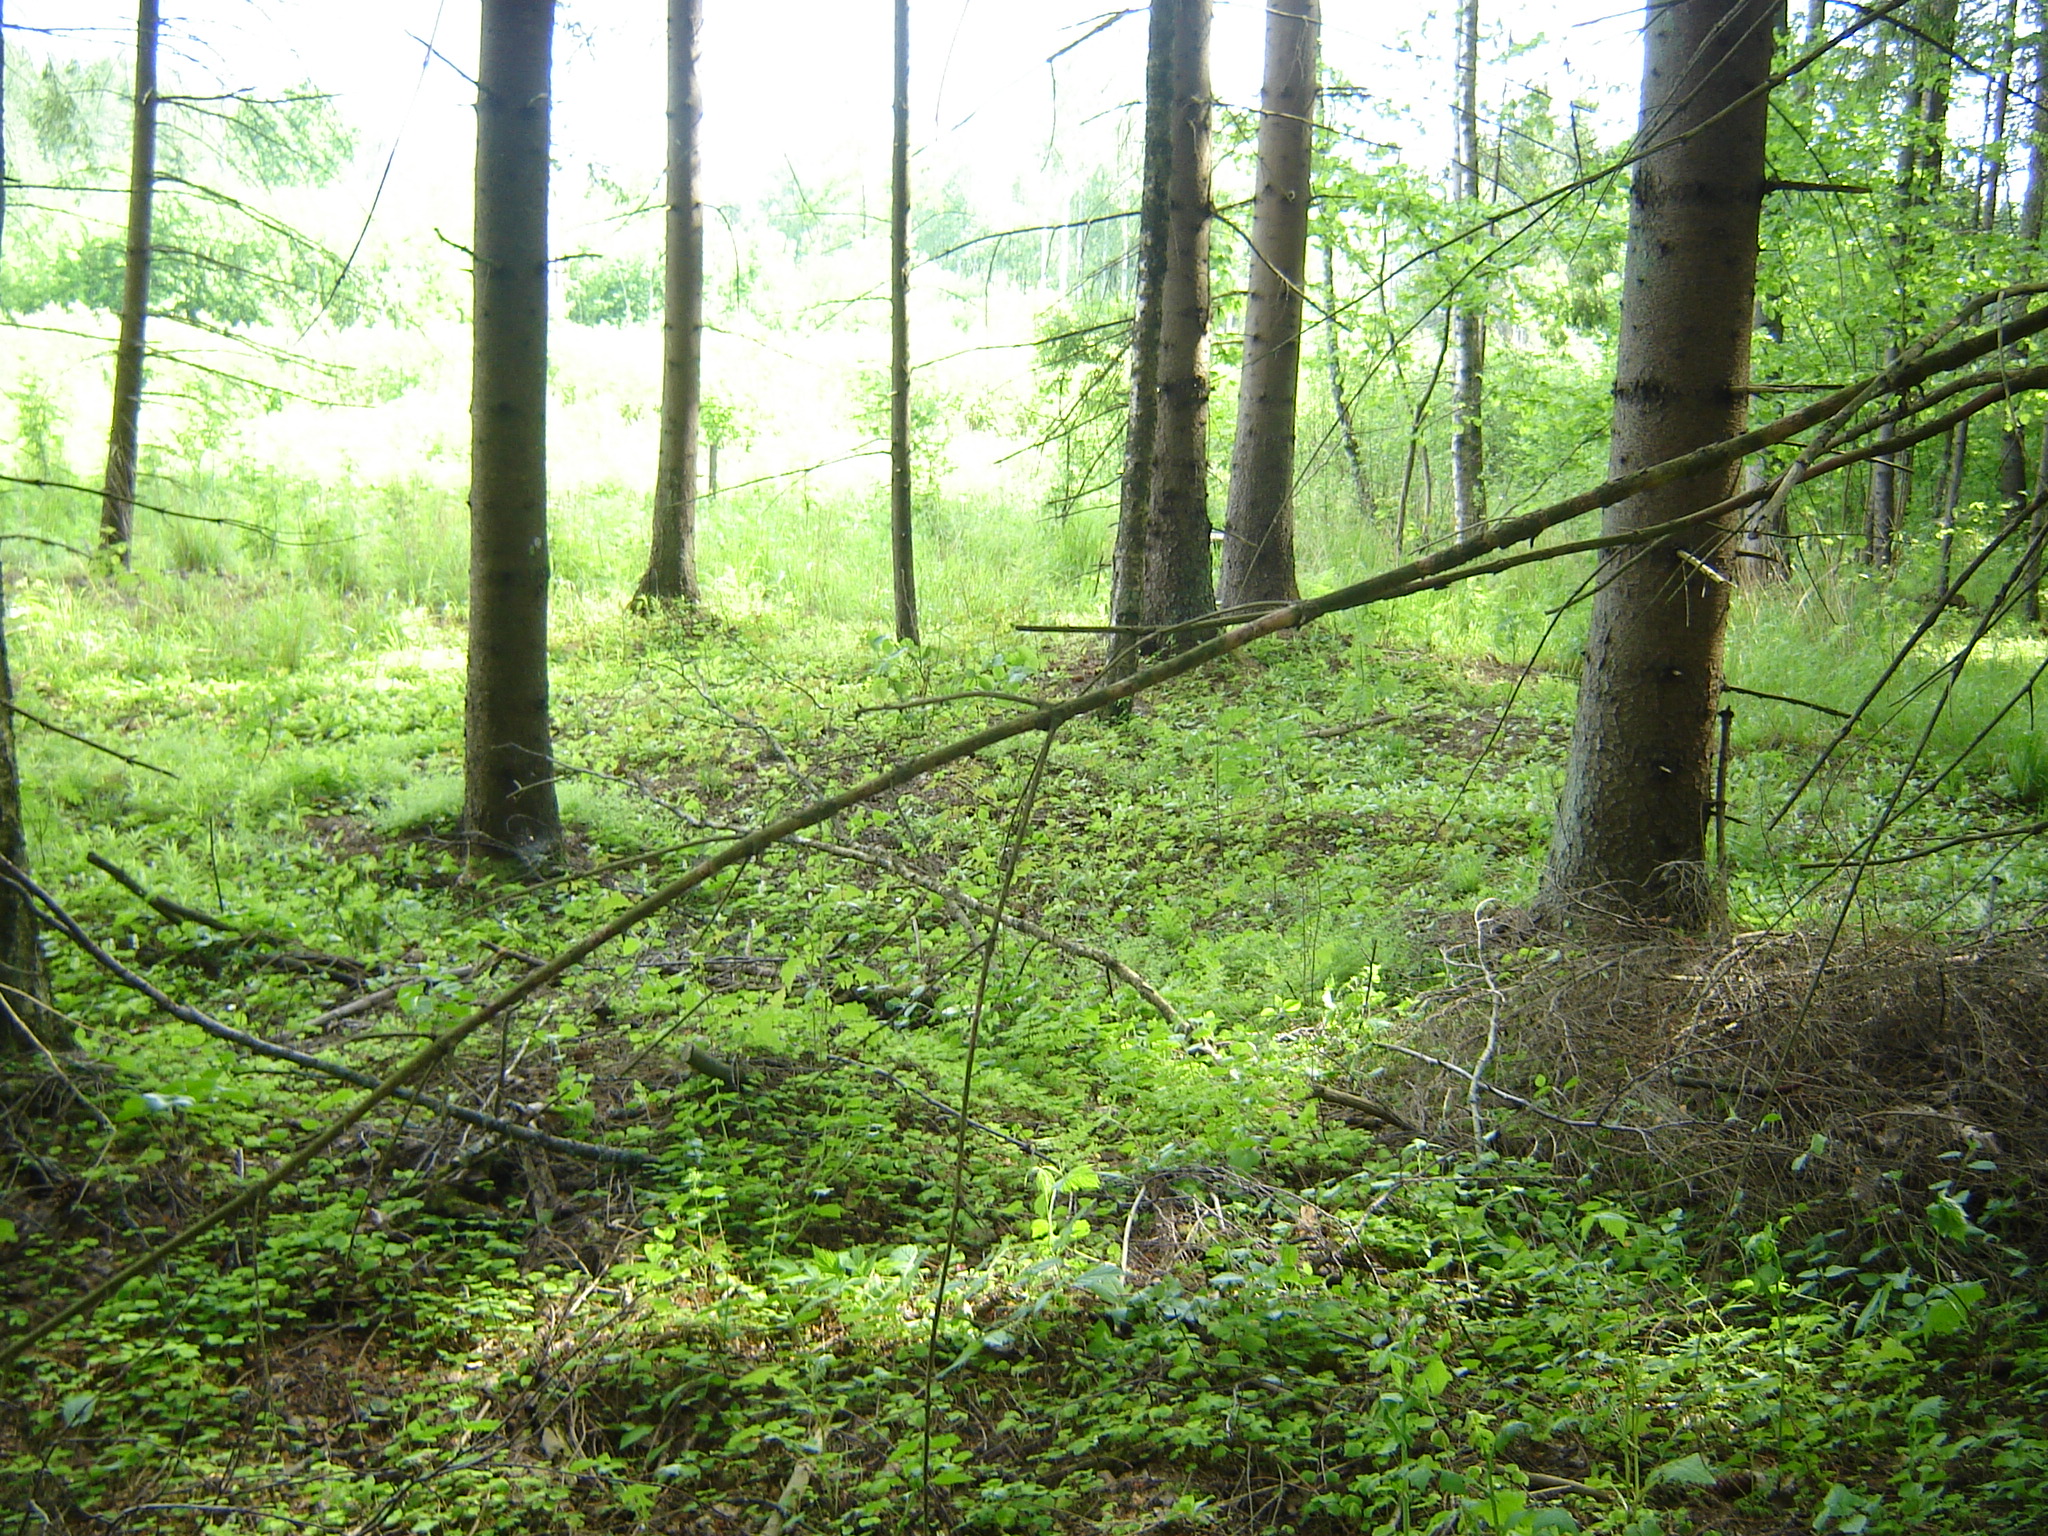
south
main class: Woodland
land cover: Spruce dominated coniferous woodland
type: hemiboreal forest and nemoral coniferous forest and mixed broadleaved-coniferous forest
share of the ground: > 75 %
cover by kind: coniferous forest trees 80 %, broadleaved forest trees 10 %, herbaceous plants 10 %
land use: Forestry
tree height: > 5 m
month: June
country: LT
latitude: 55.9083
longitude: 25.2658
